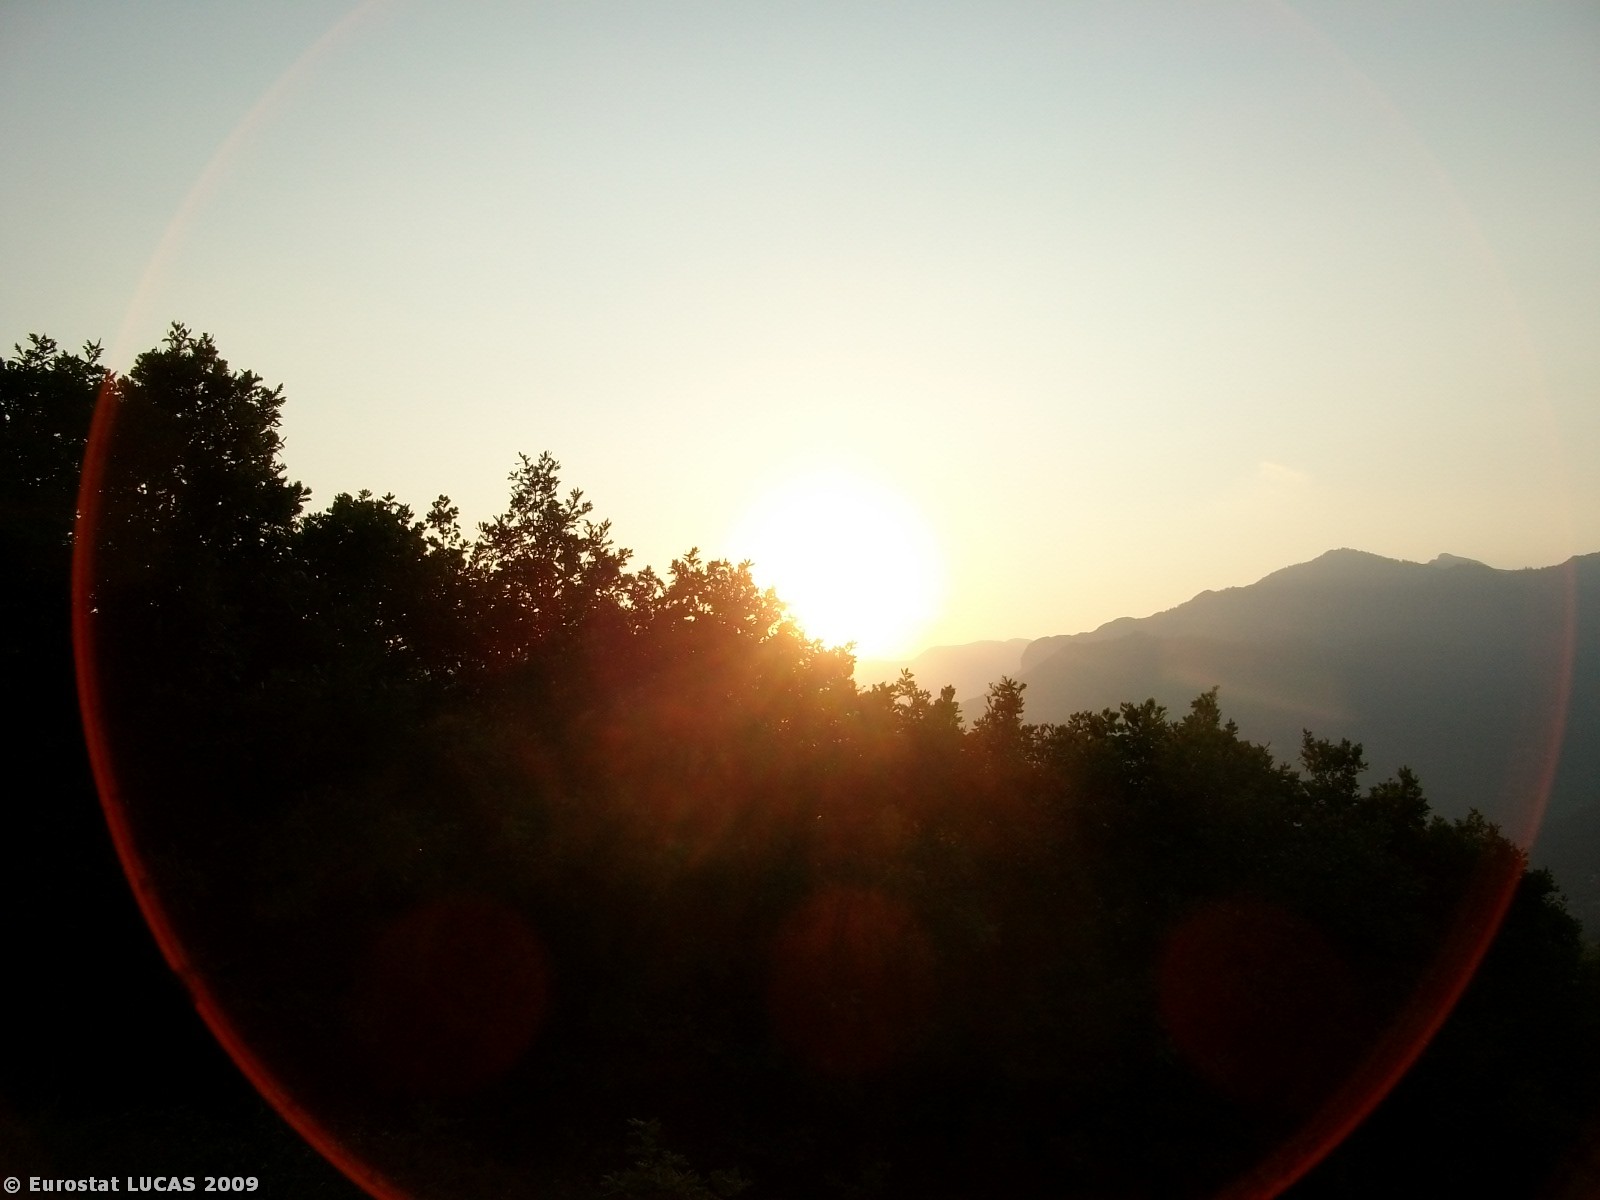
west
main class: Woodland
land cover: Broadleaved woodland
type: thermophilous deciduous forest
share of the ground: > 75 %
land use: Forestry
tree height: > 5 m
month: August
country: GR
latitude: 39.4323
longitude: 21.5866
